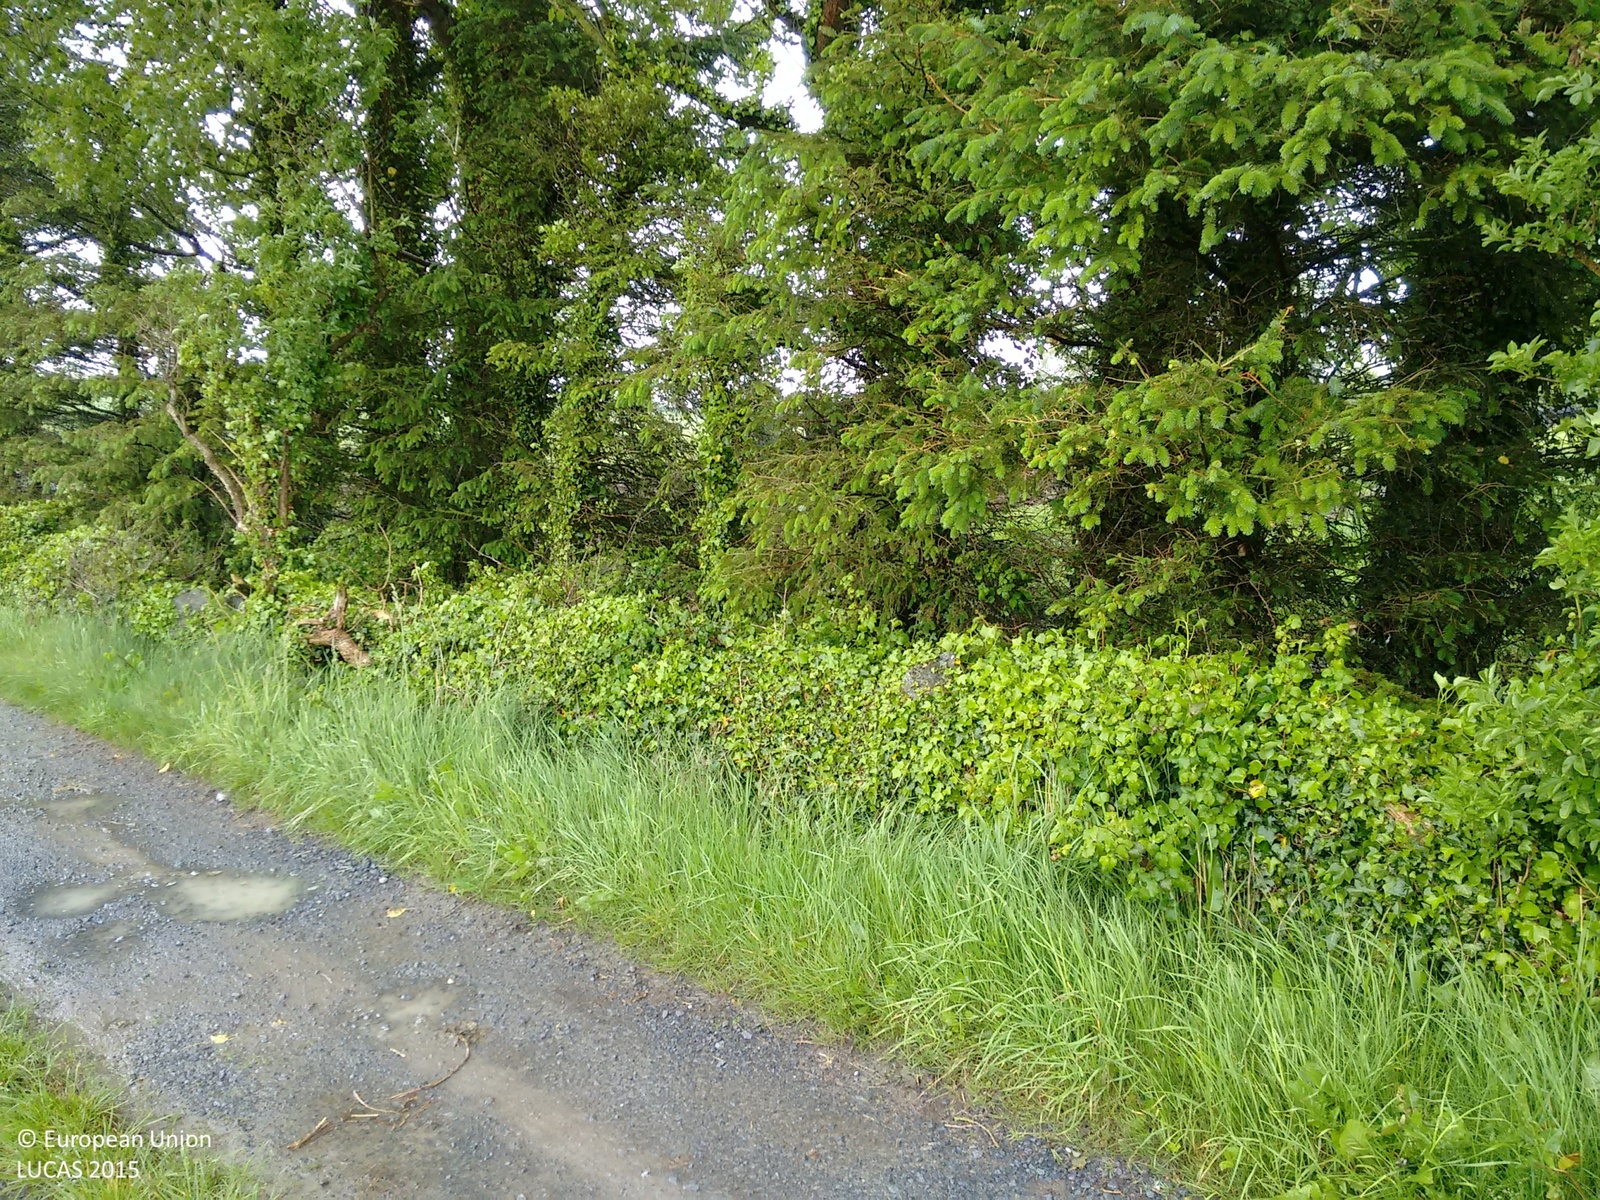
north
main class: Grassland
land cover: Grassland without tree/shrub cover
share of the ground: > 75 %
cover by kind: herbaceous plants 100 %
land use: Agriculture (excluding fallow land and kitchen gardens)
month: May
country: IE
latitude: 53.1108
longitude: -8.8041
